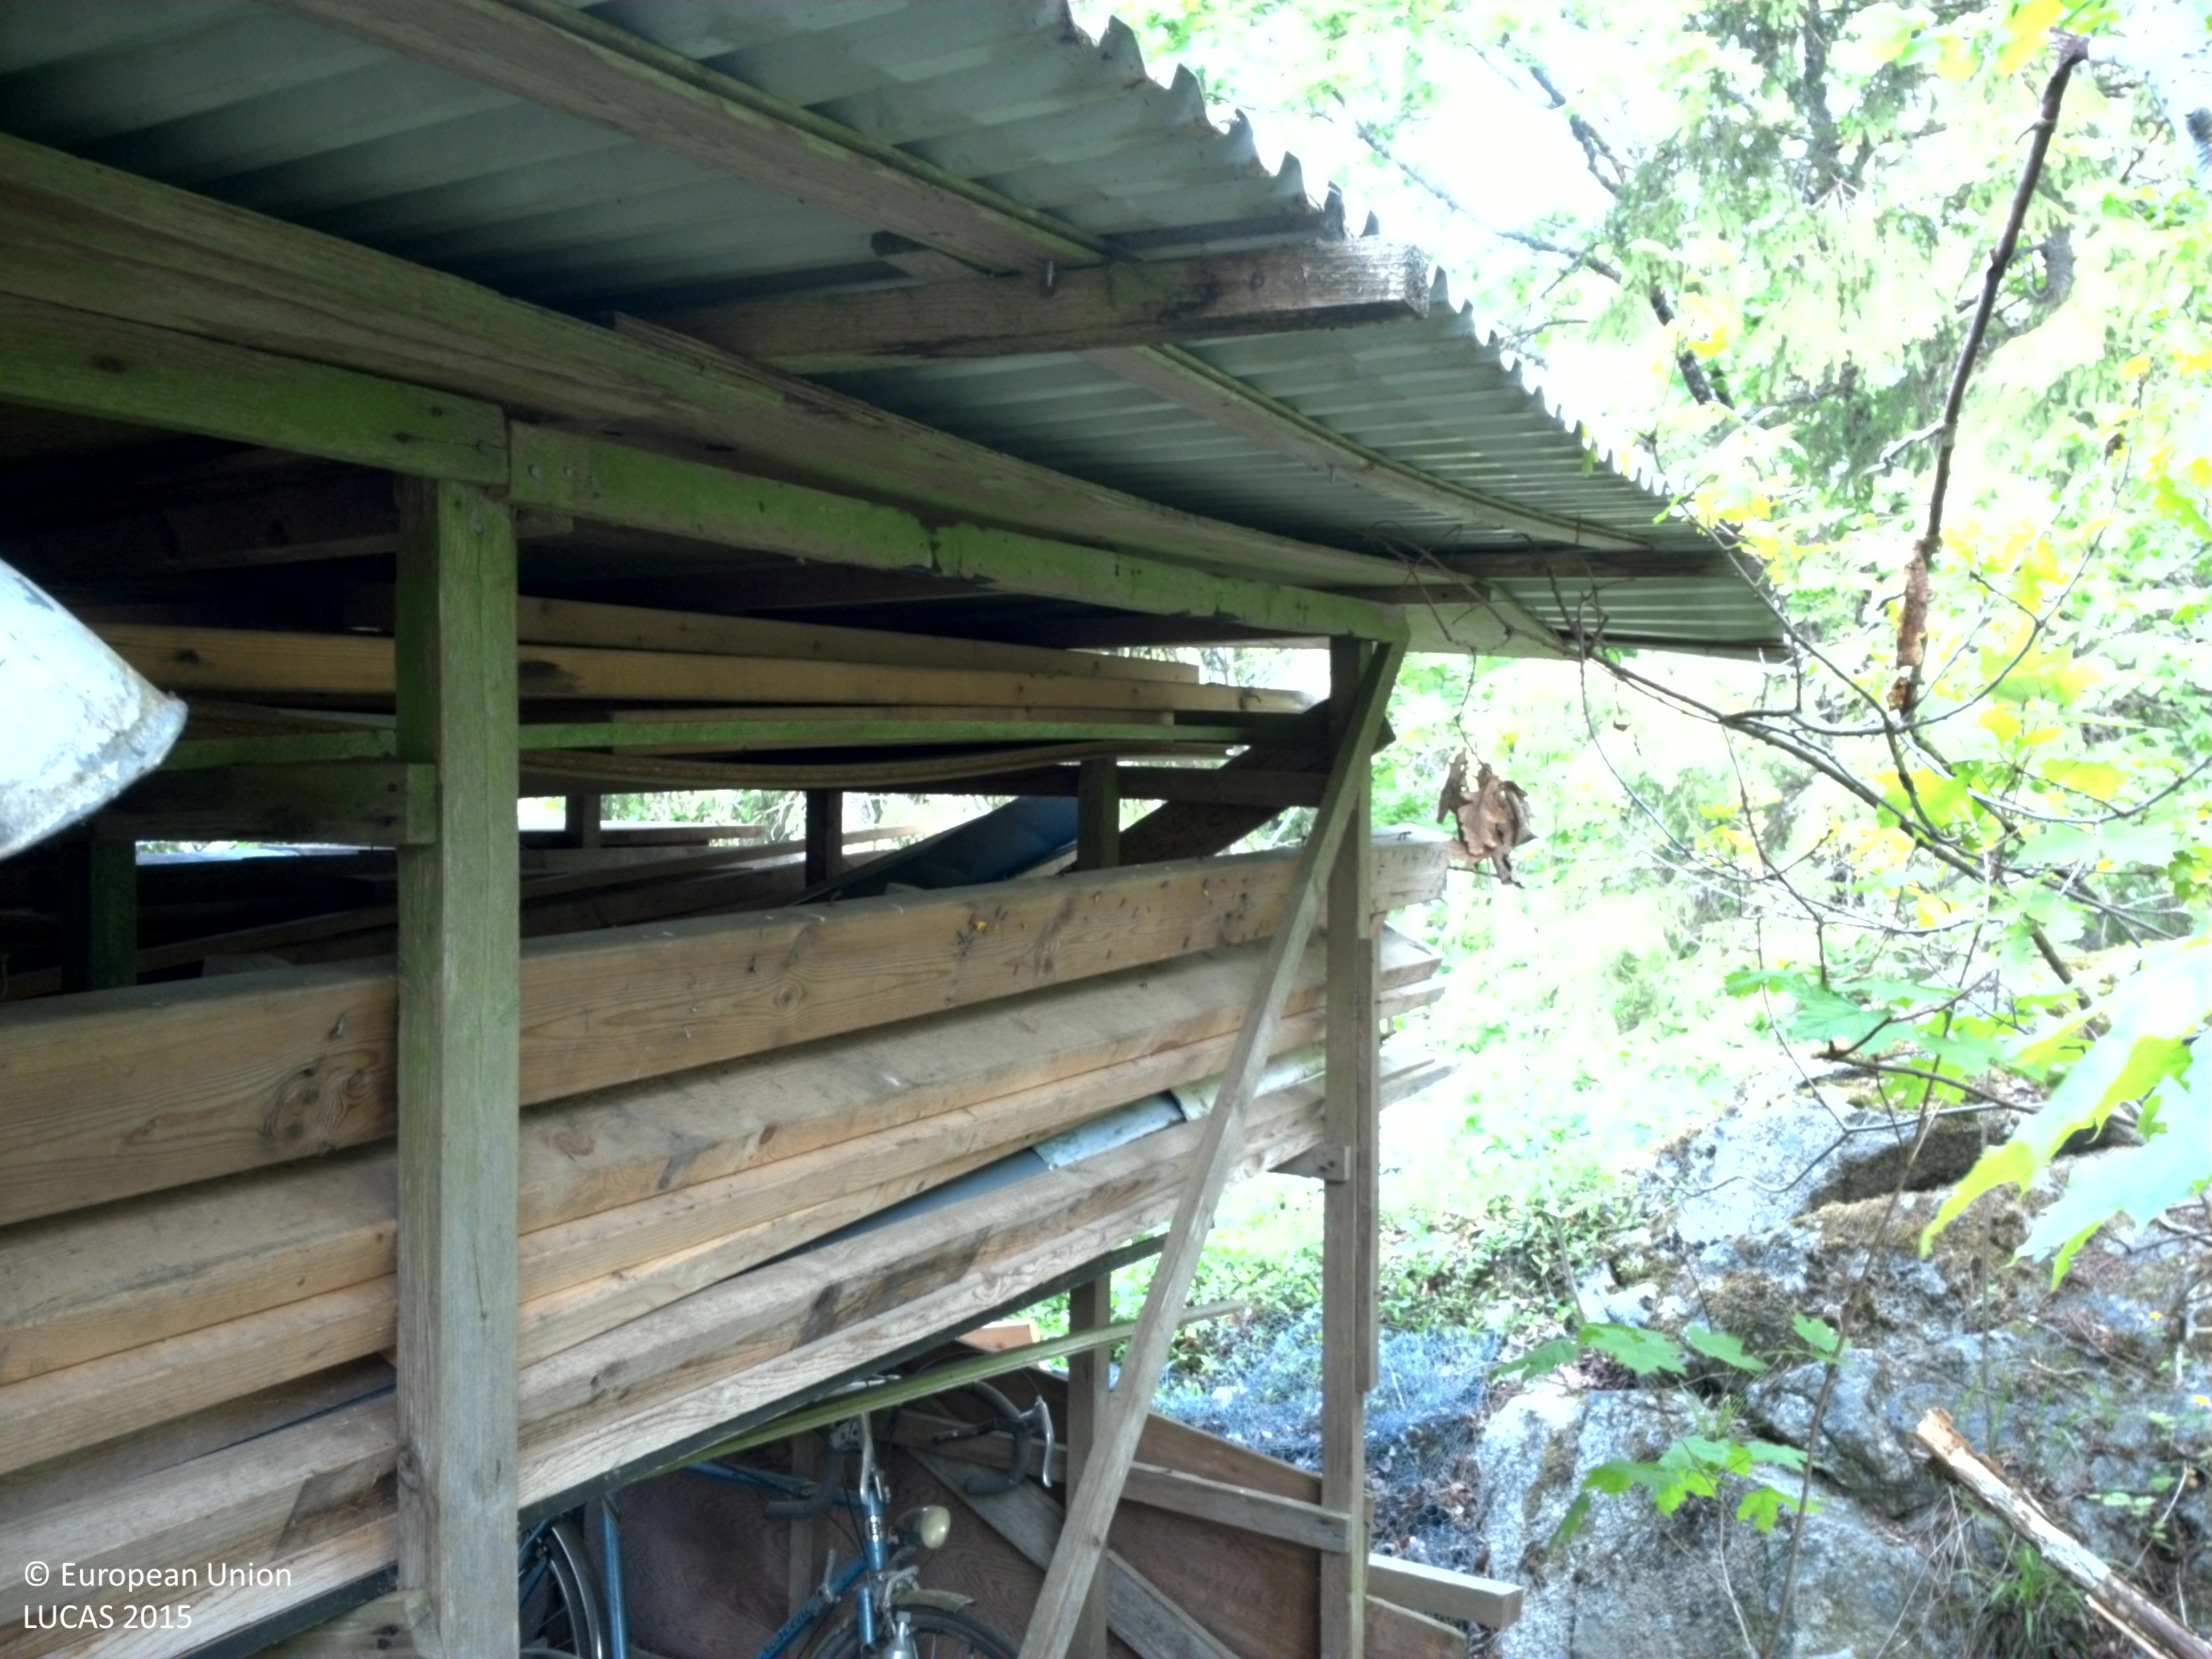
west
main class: Woodland
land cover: Spruce dominated mixed woodland
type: hemiboreal forest and nemoral coniferous forest and mixed broadleaved-coniferous forest
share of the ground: > 75 %
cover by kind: coniferous forest trees 50 %, broadleaved forest trees 30 %, shrubs 10 %, herbaceous plants 5 %, lichens and mosses 5 %
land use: Forestry
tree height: > 5 m
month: June
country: SE
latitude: 59.7574
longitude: 18.8475
